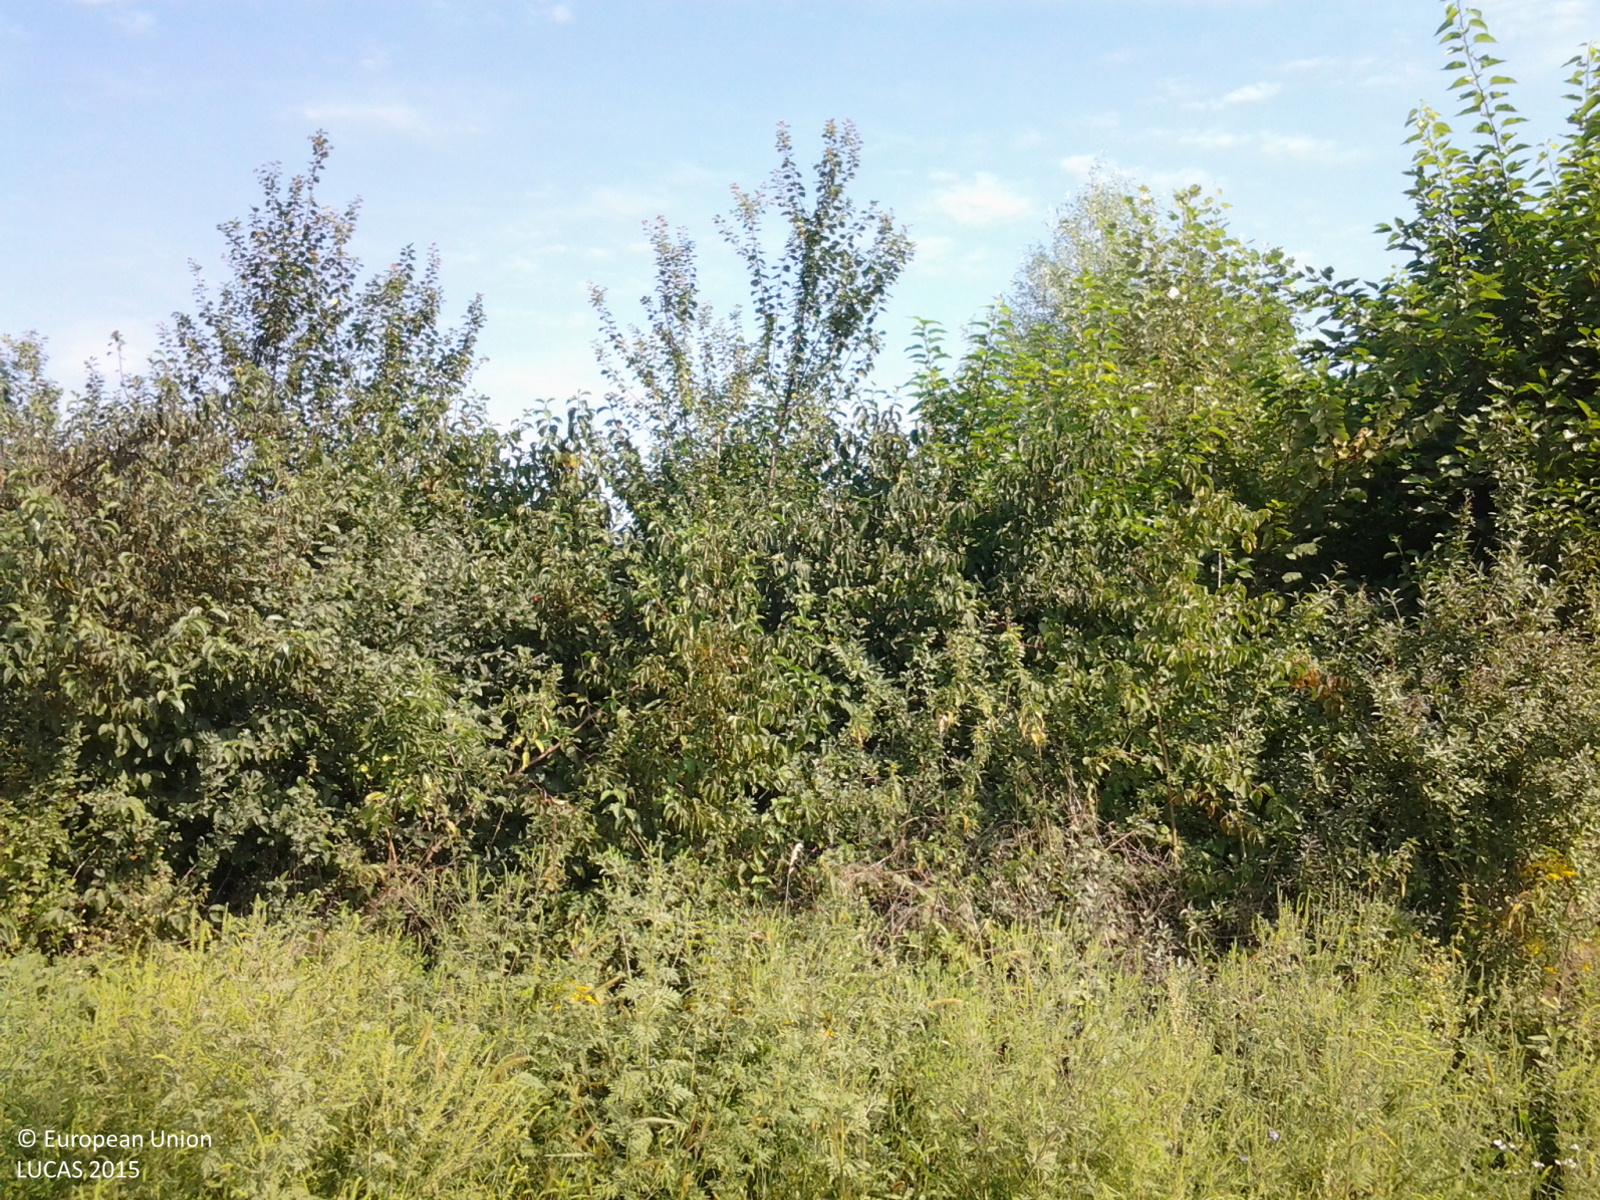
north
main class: Grassland
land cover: Grassland without tree/shrub cover
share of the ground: > 75 %
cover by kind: herbaceous plants 100 %
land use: Agriculture (excluding fallow land and kitchen gardens)
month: August
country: HU
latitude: 46.5055
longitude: 17.2102
